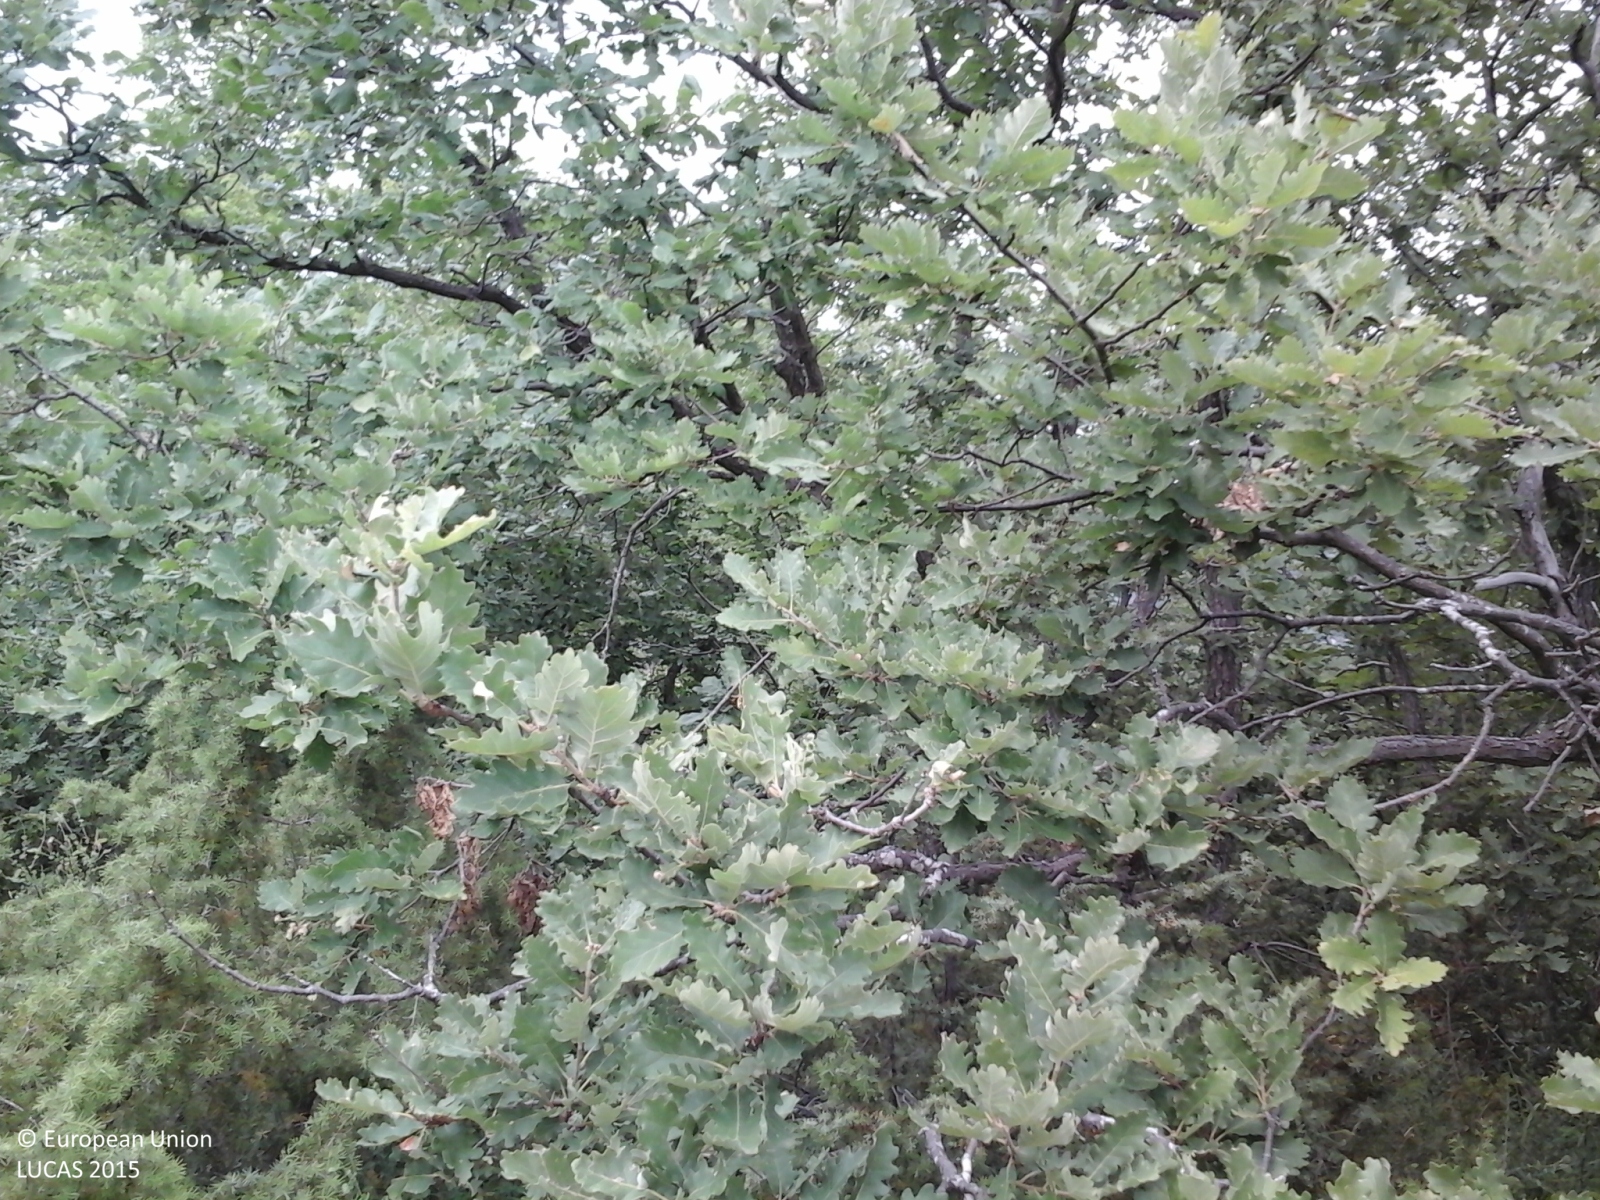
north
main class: Woodland
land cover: Broadleaved woodland
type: thermophilous deciduous forest
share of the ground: > 75 %
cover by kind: broadleaved forest trees 95 %, shrubs 5 %
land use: Semi-natural and natural areas not in use
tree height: > 5 m
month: June
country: IT
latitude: 44.1753
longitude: 11.6347
